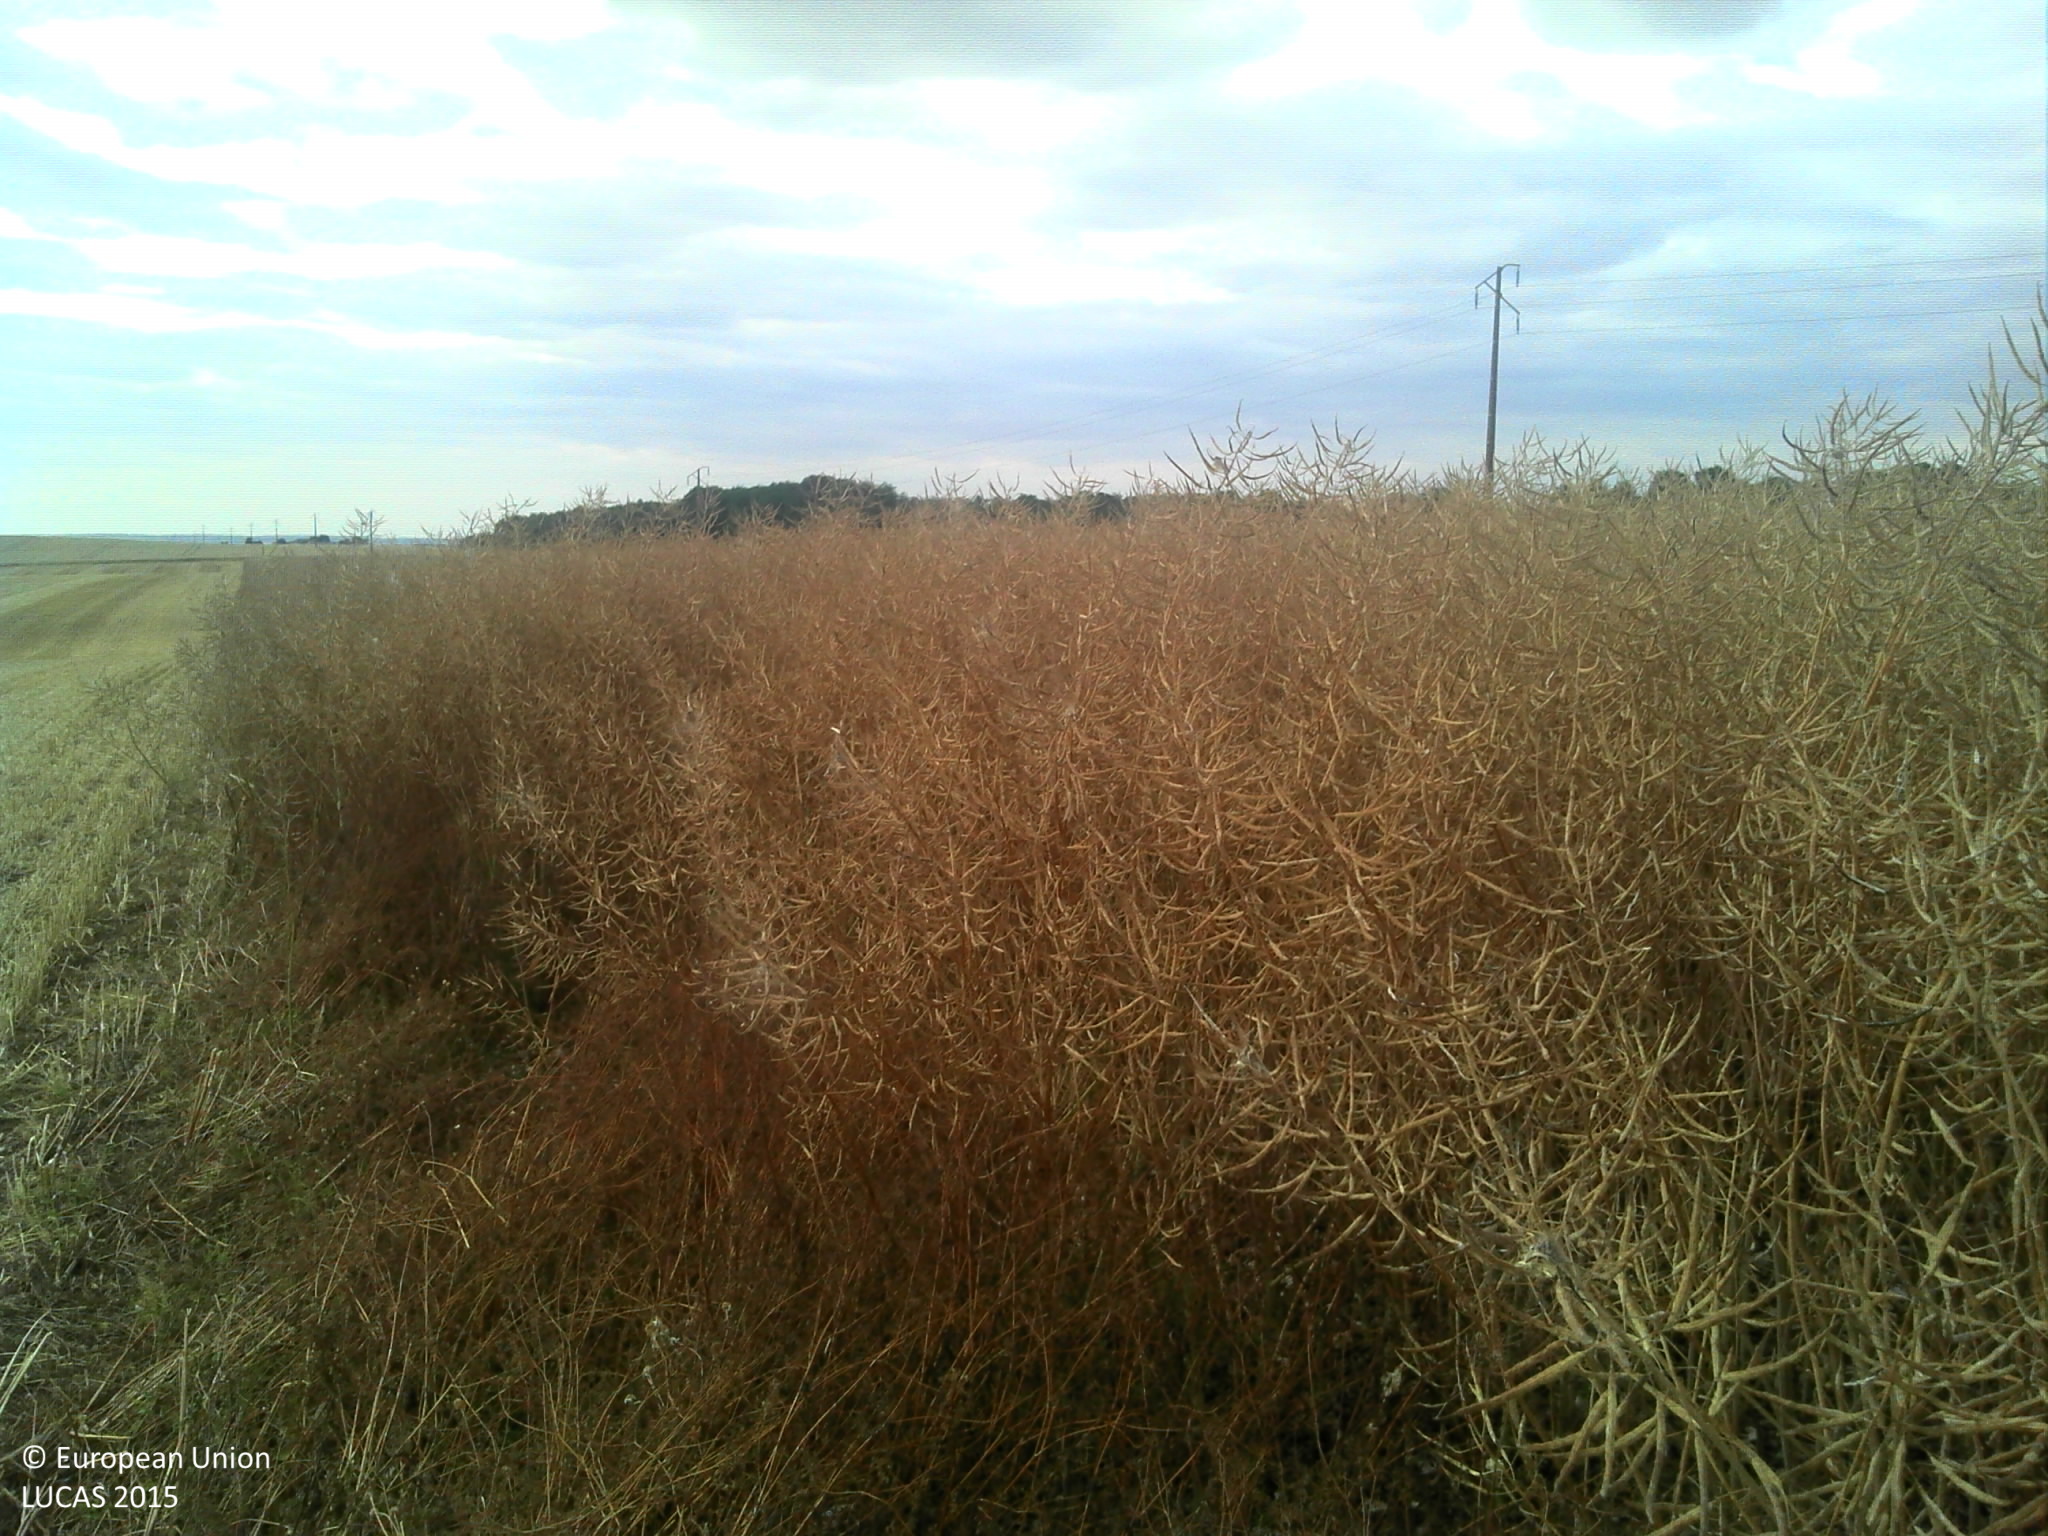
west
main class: Cropland
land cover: Rape and turnip rape
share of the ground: > 75 %
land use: Agriculture (excluding fallow land and kitchen gardens)
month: July
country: FR
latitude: 48.1024
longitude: 5.2321
